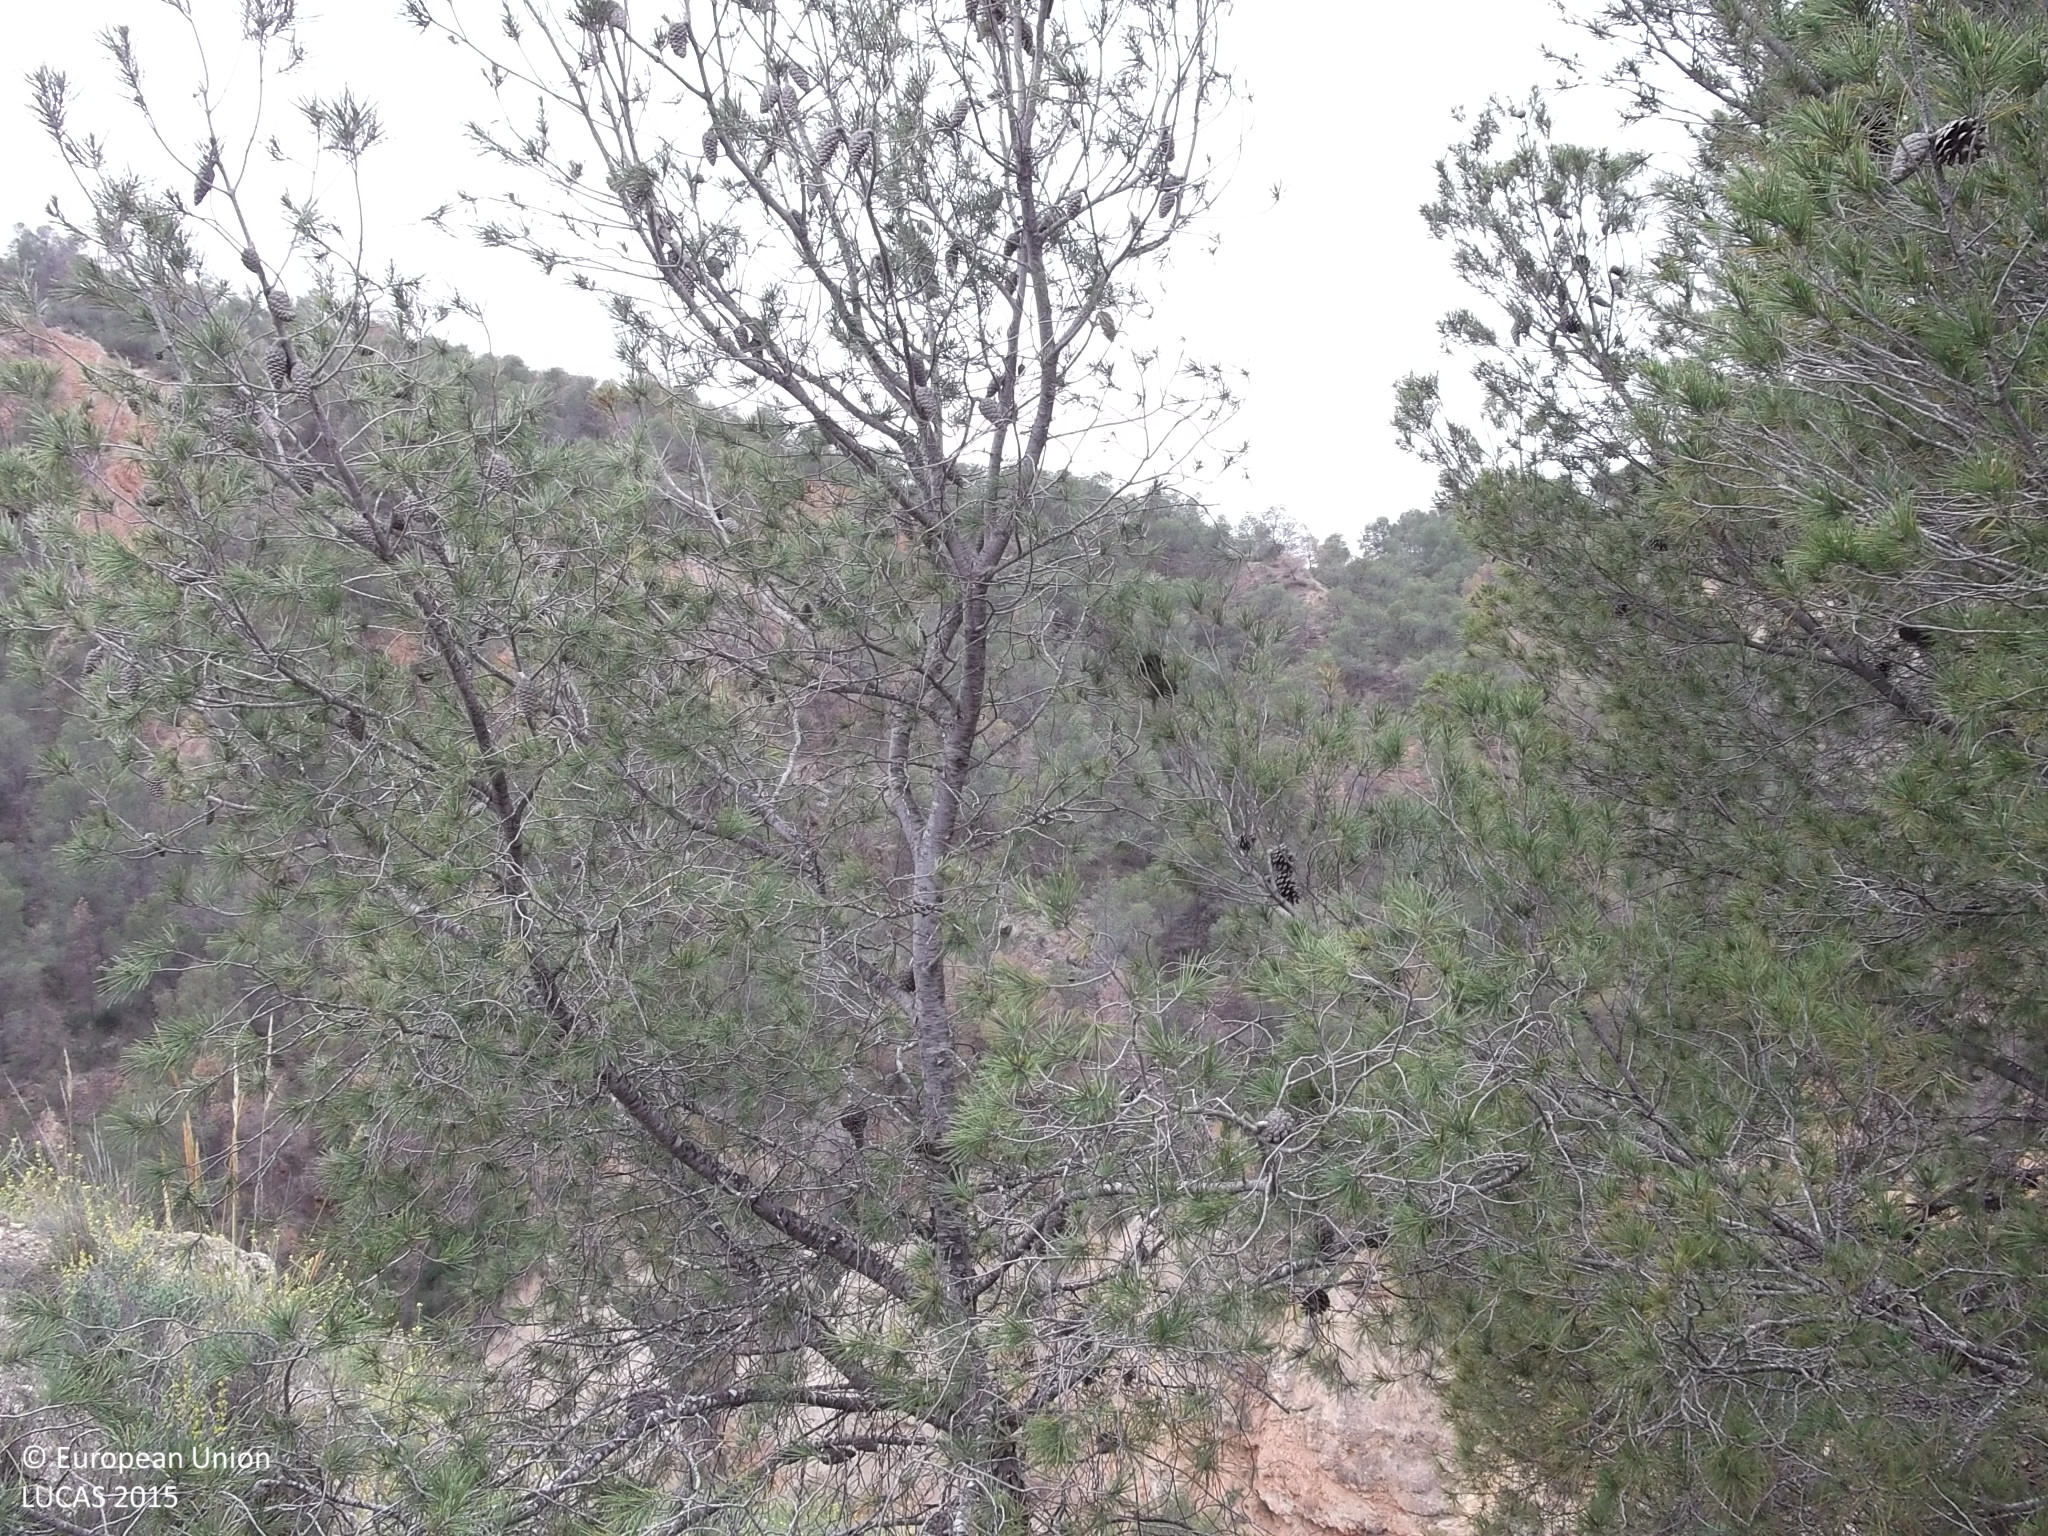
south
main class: Woodland
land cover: Pine dominated coniferous woodland
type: coniferous forest of the mediterranean region
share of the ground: 10 - 25 %
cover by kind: shrubs 40 %, consolidated bare surface 40 %, coniferous forest trees 20 %
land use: Semi-natural and natural areas not in use
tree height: > 5 m
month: April
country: ES
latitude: 37.9050
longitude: -1.3686
